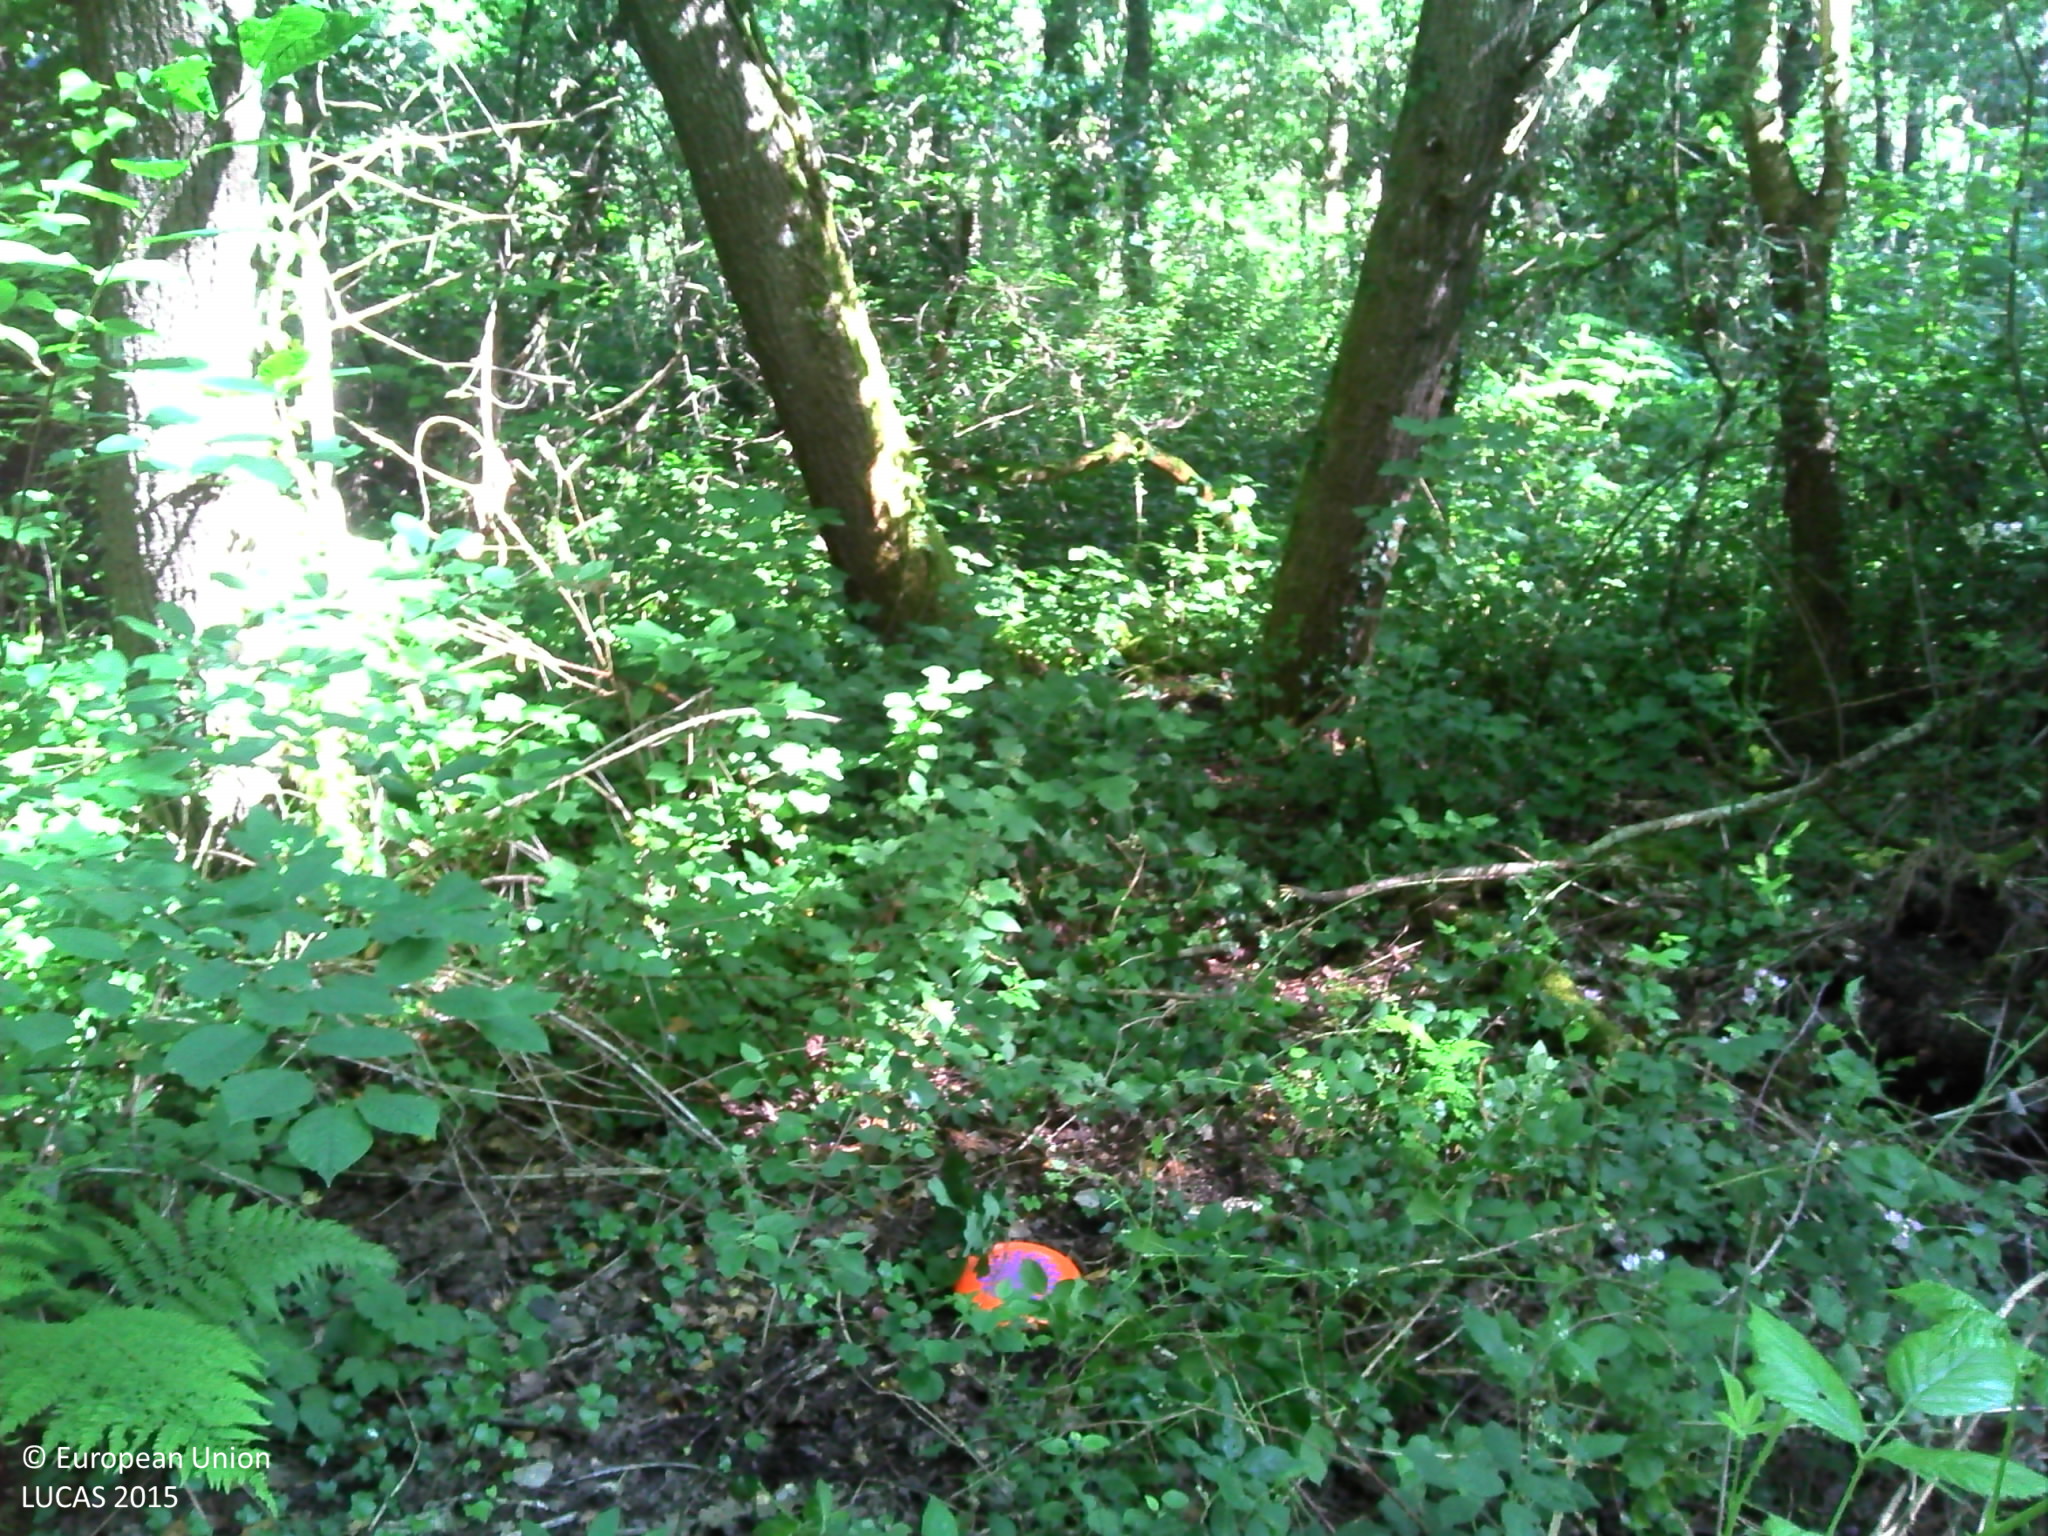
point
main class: Woodland
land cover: Broadleaved woodland
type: acidophilous oak and oak-birch forest
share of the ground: > 75 %
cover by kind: broadleaved forest trees 75 %, herbaceous plants 15 %, shrubs 10 %
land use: Forestry
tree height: > 5 m
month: June
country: FR
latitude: 47.9146
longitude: 0.2200
